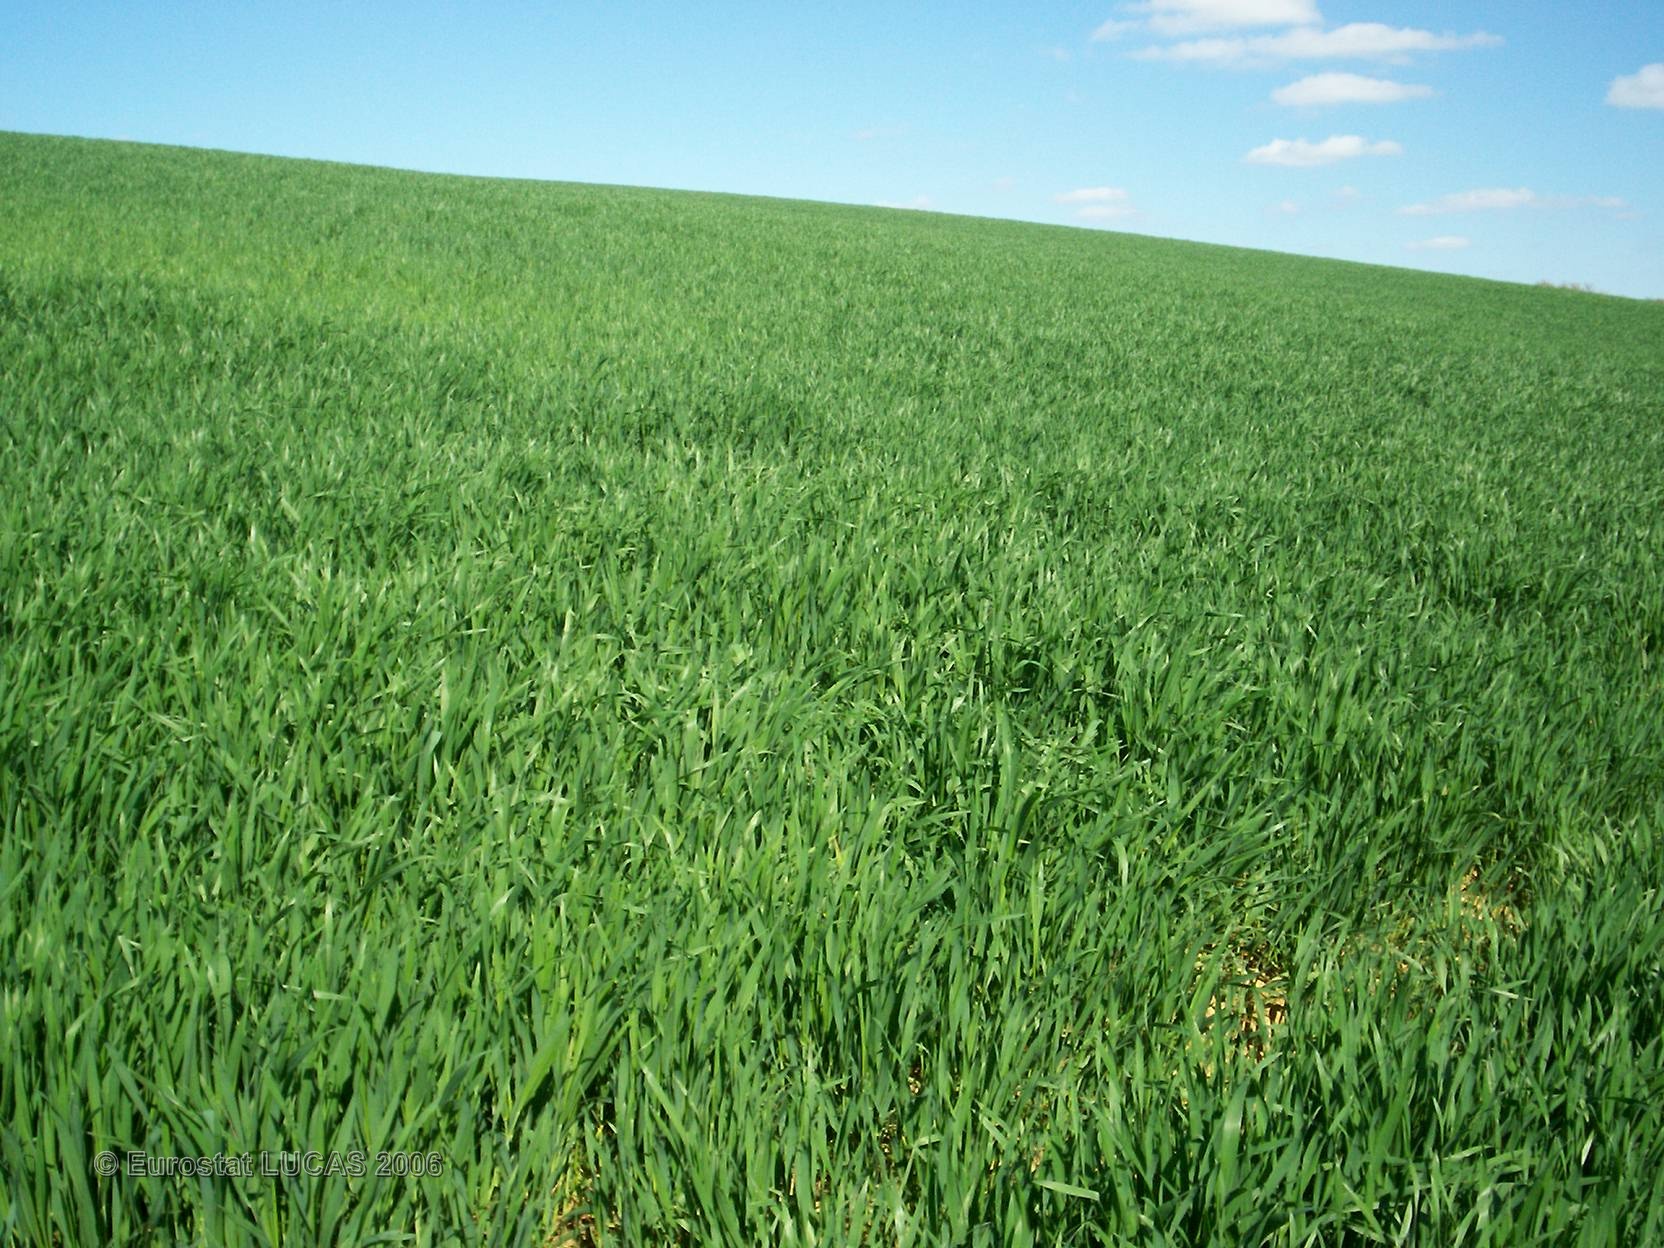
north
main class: Cropland
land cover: Common wheat
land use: Agriculture (excluding fallow land and kitchen gardens)
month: April
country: FR
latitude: 43.5233
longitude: 0.2096
